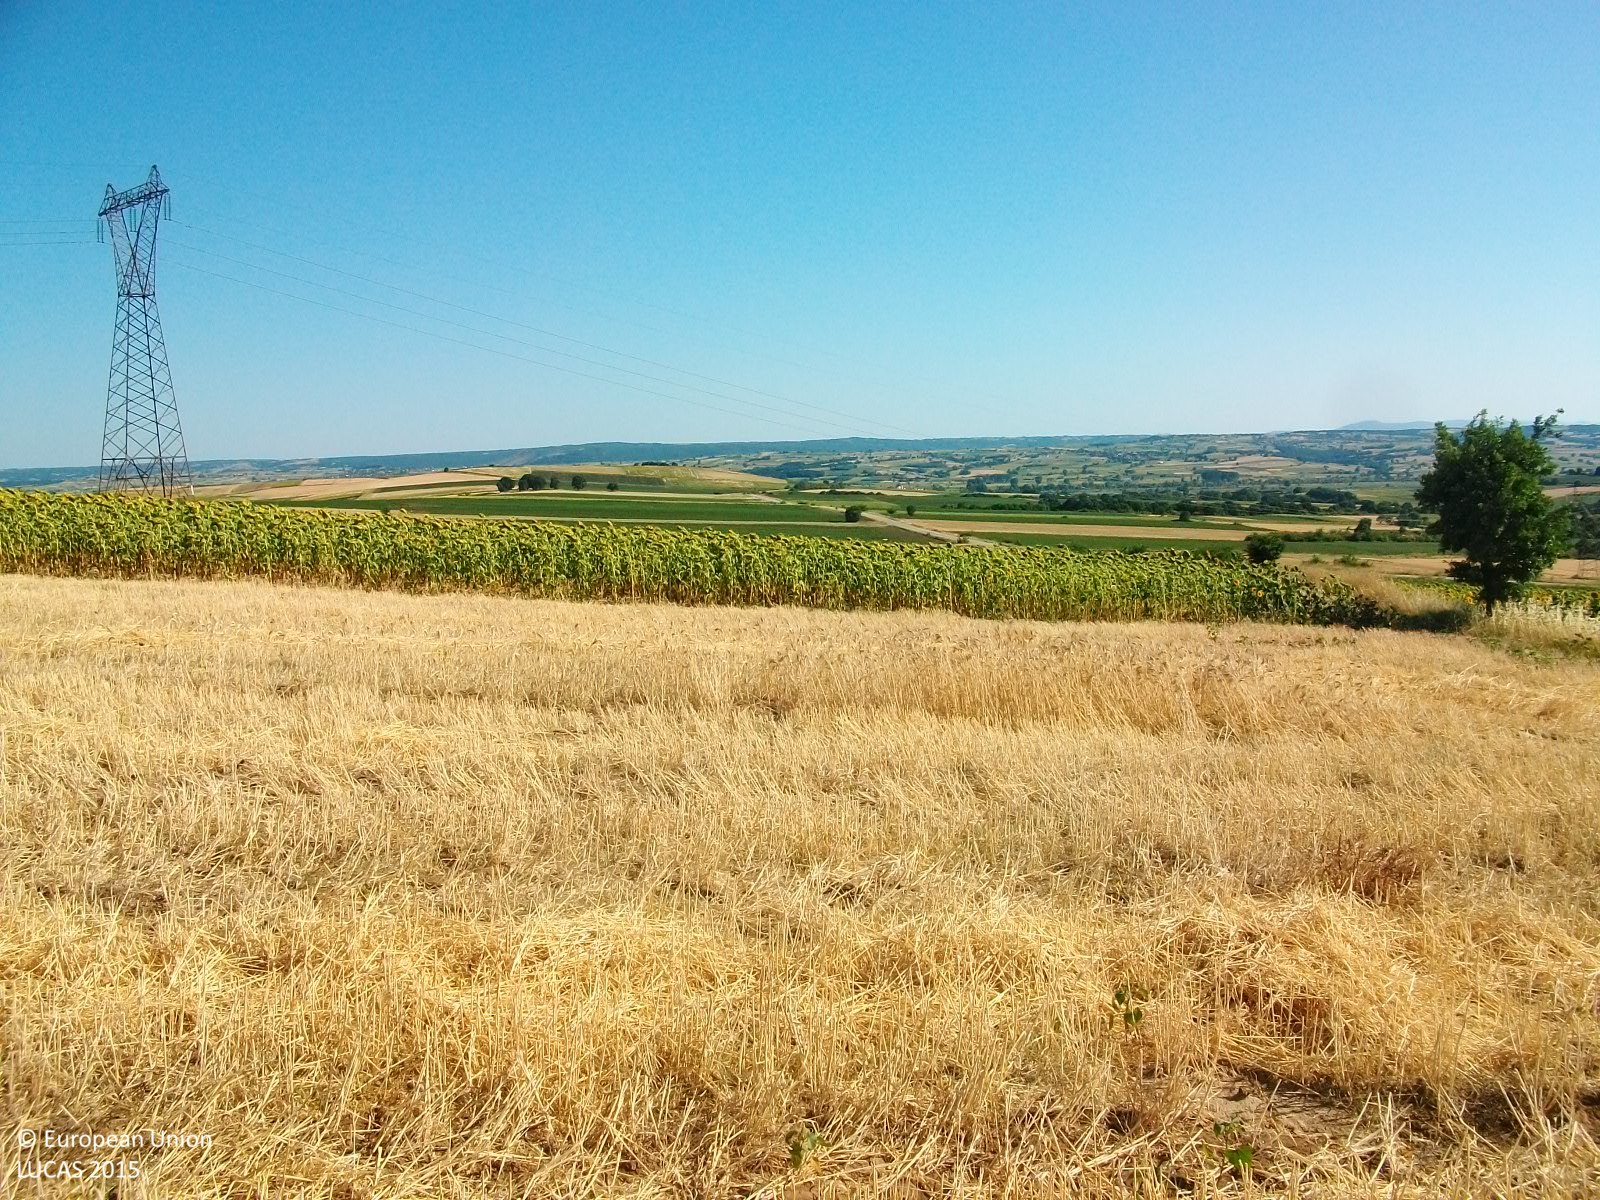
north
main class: Cropland
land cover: Common wheat
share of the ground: > 75 %
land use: Agriculture (excluding fallow land and kitchen gardens)
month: July
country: GR
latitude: 41.4667
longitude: 26.3221
